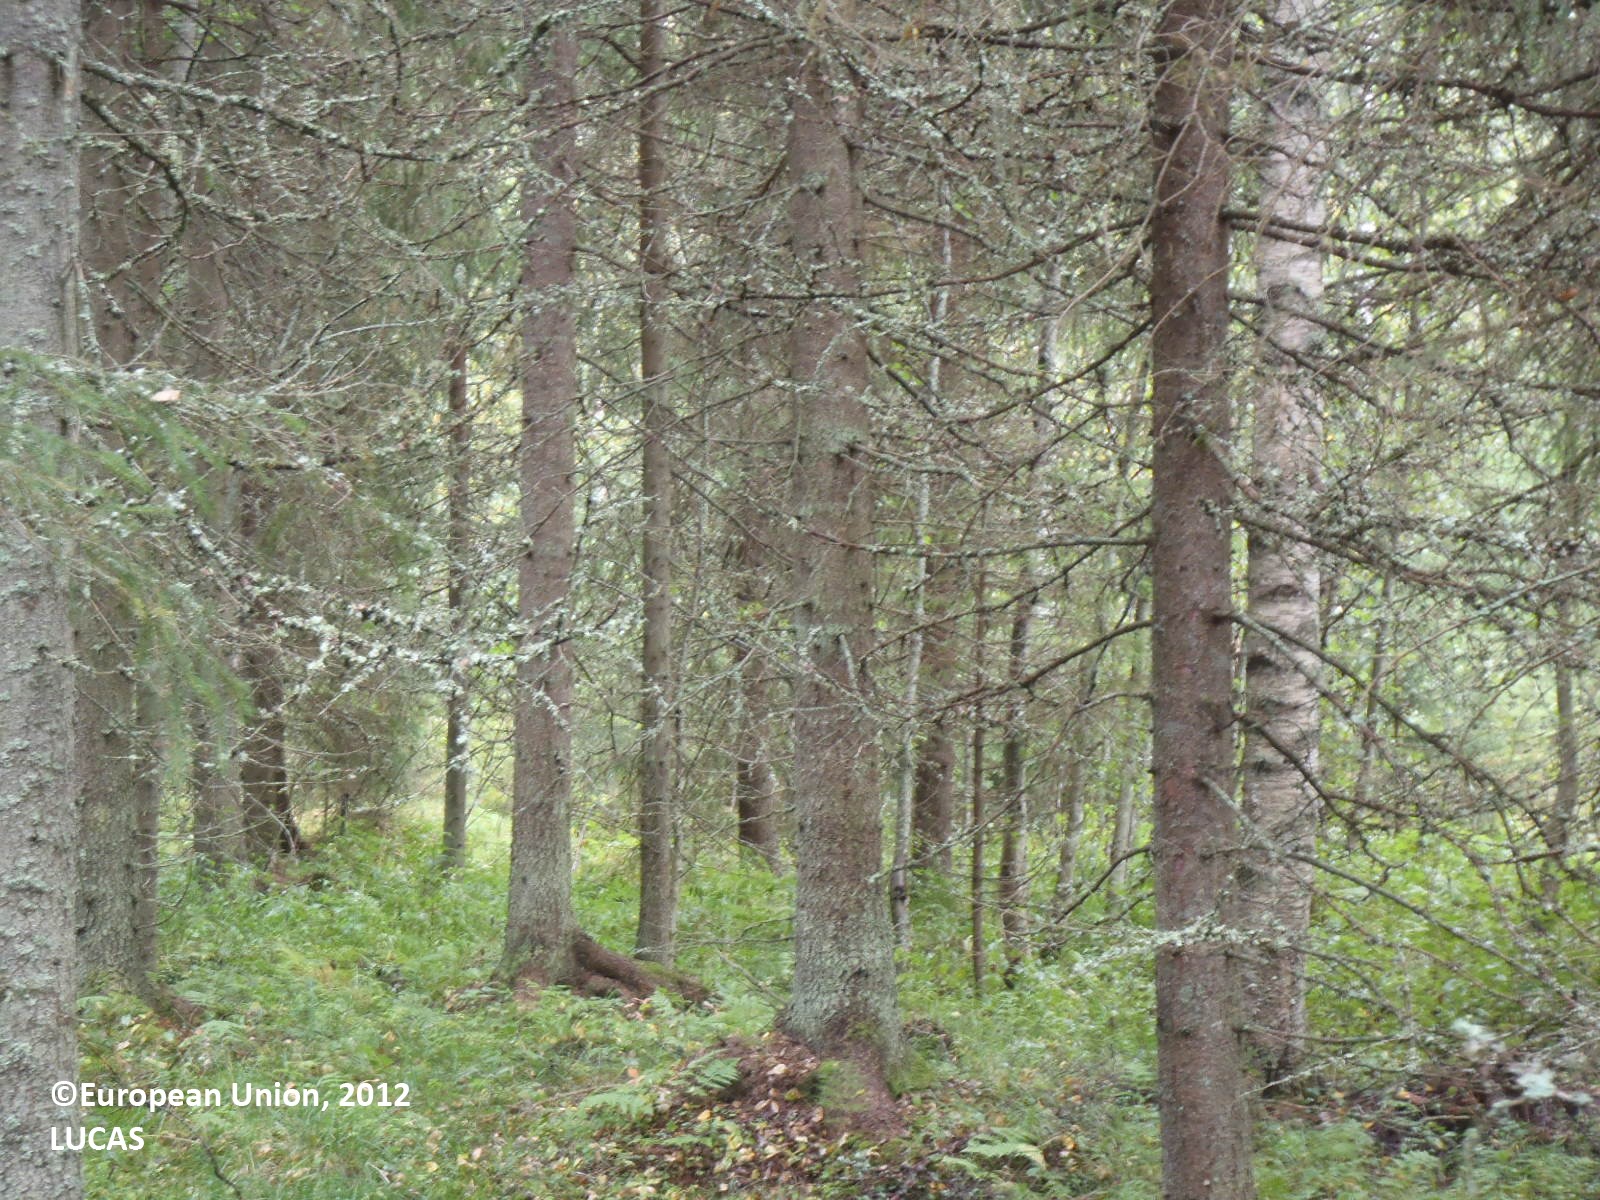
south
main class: Woodland
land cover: Broadleaved woodland
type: boreal forest
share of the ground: > 75 %
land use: Forestry
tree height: > 5 m
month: September
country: FI
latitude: 61.5679
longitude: 22.8140
